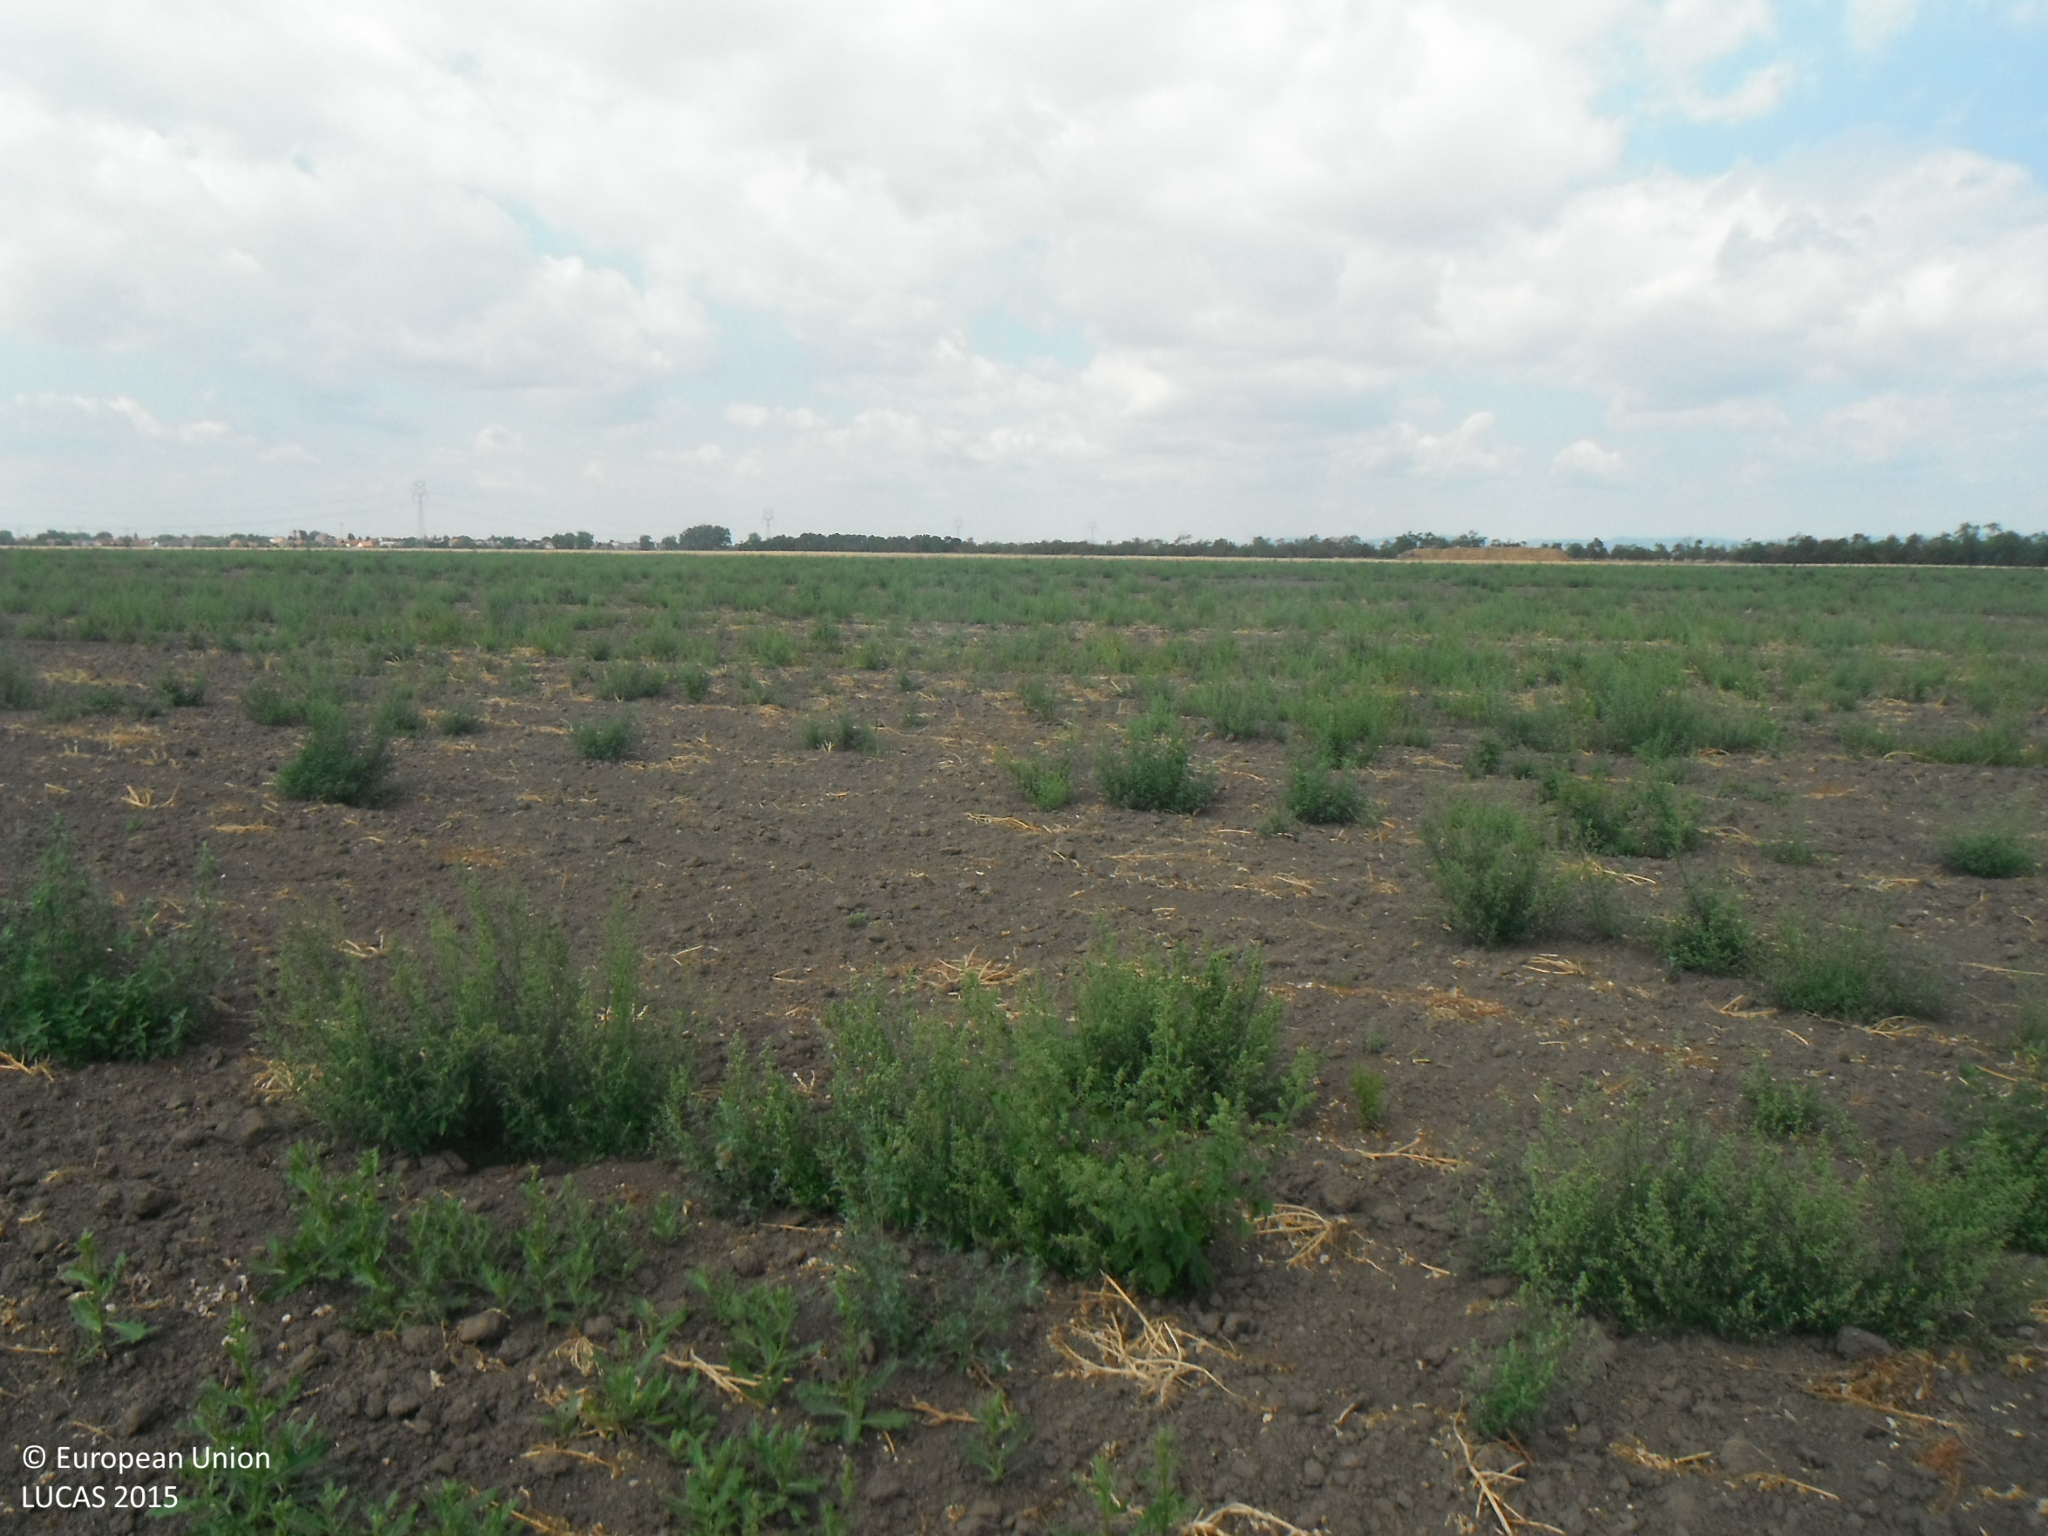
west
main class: Grassland
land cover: Spontaneously vegetated surfaces
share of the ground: 25 - 50 %
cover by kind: unconsolidated bare surface 65 %, herbaceous plants 35 %
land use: Fallow land
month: July
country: SK
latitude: 48.1024
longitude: 17.3817
